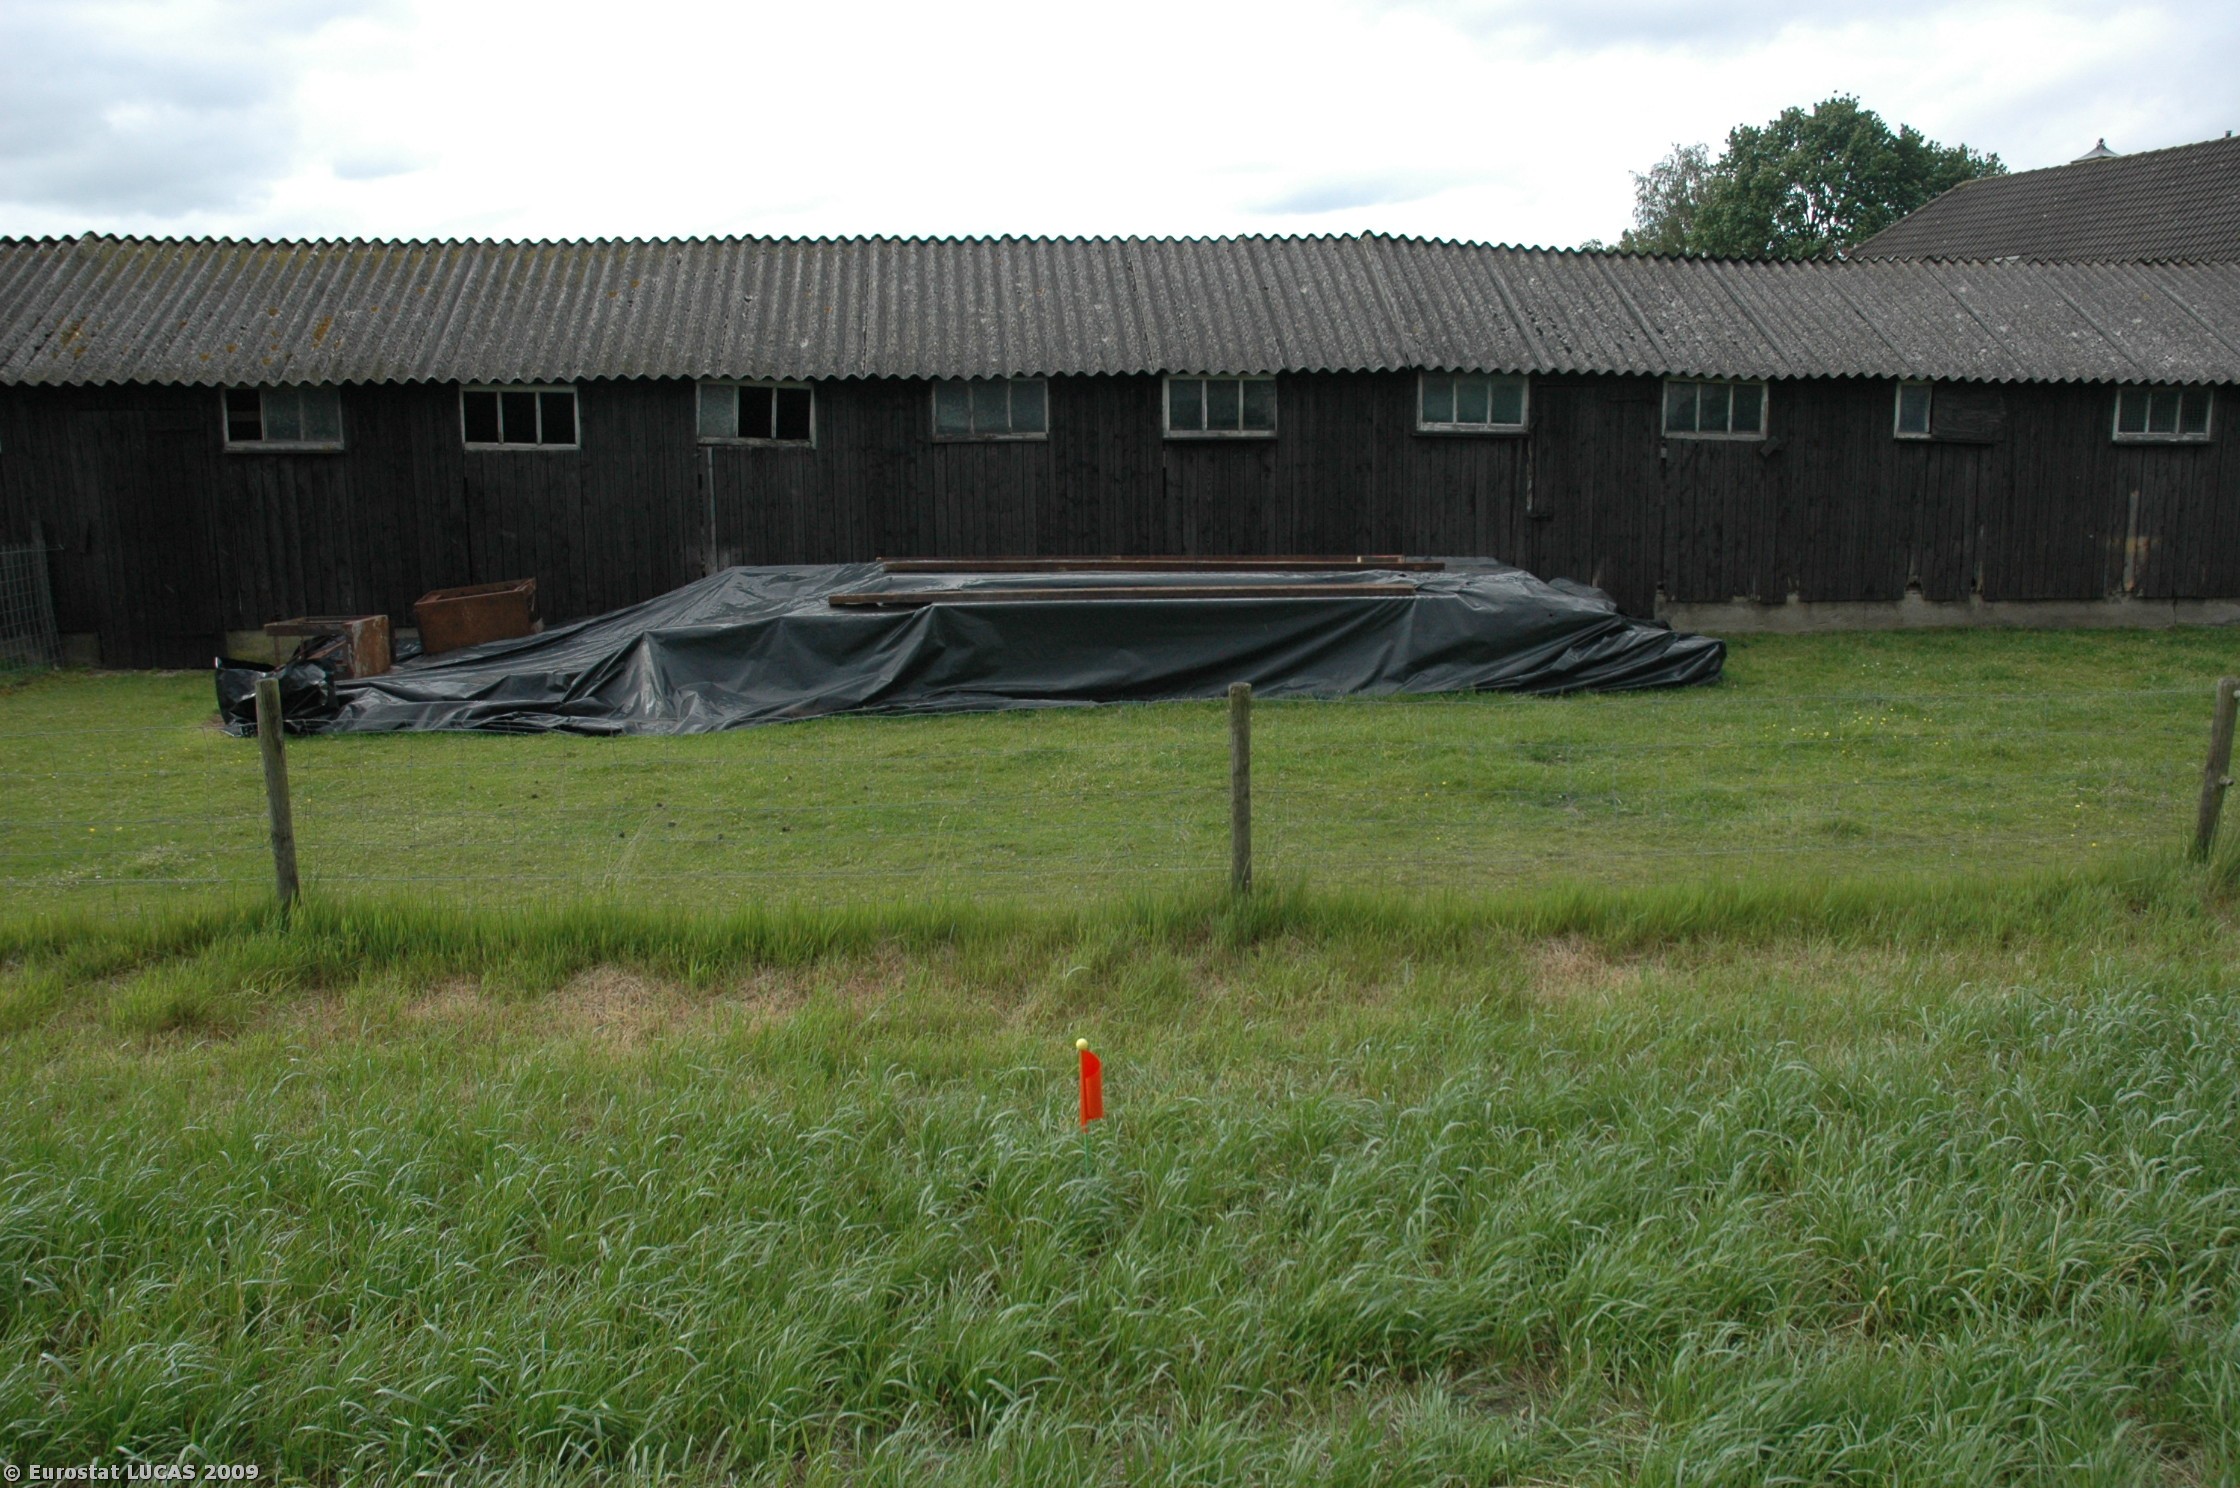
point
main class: Grassland
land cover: Grassland without tree/shrub cover
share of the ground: > 75 %
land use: Agriculture (excluding fallow land and kitchen gardens)
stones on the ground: < 10 %
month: May
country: NL
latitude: 52.1193
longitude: 5.6902
